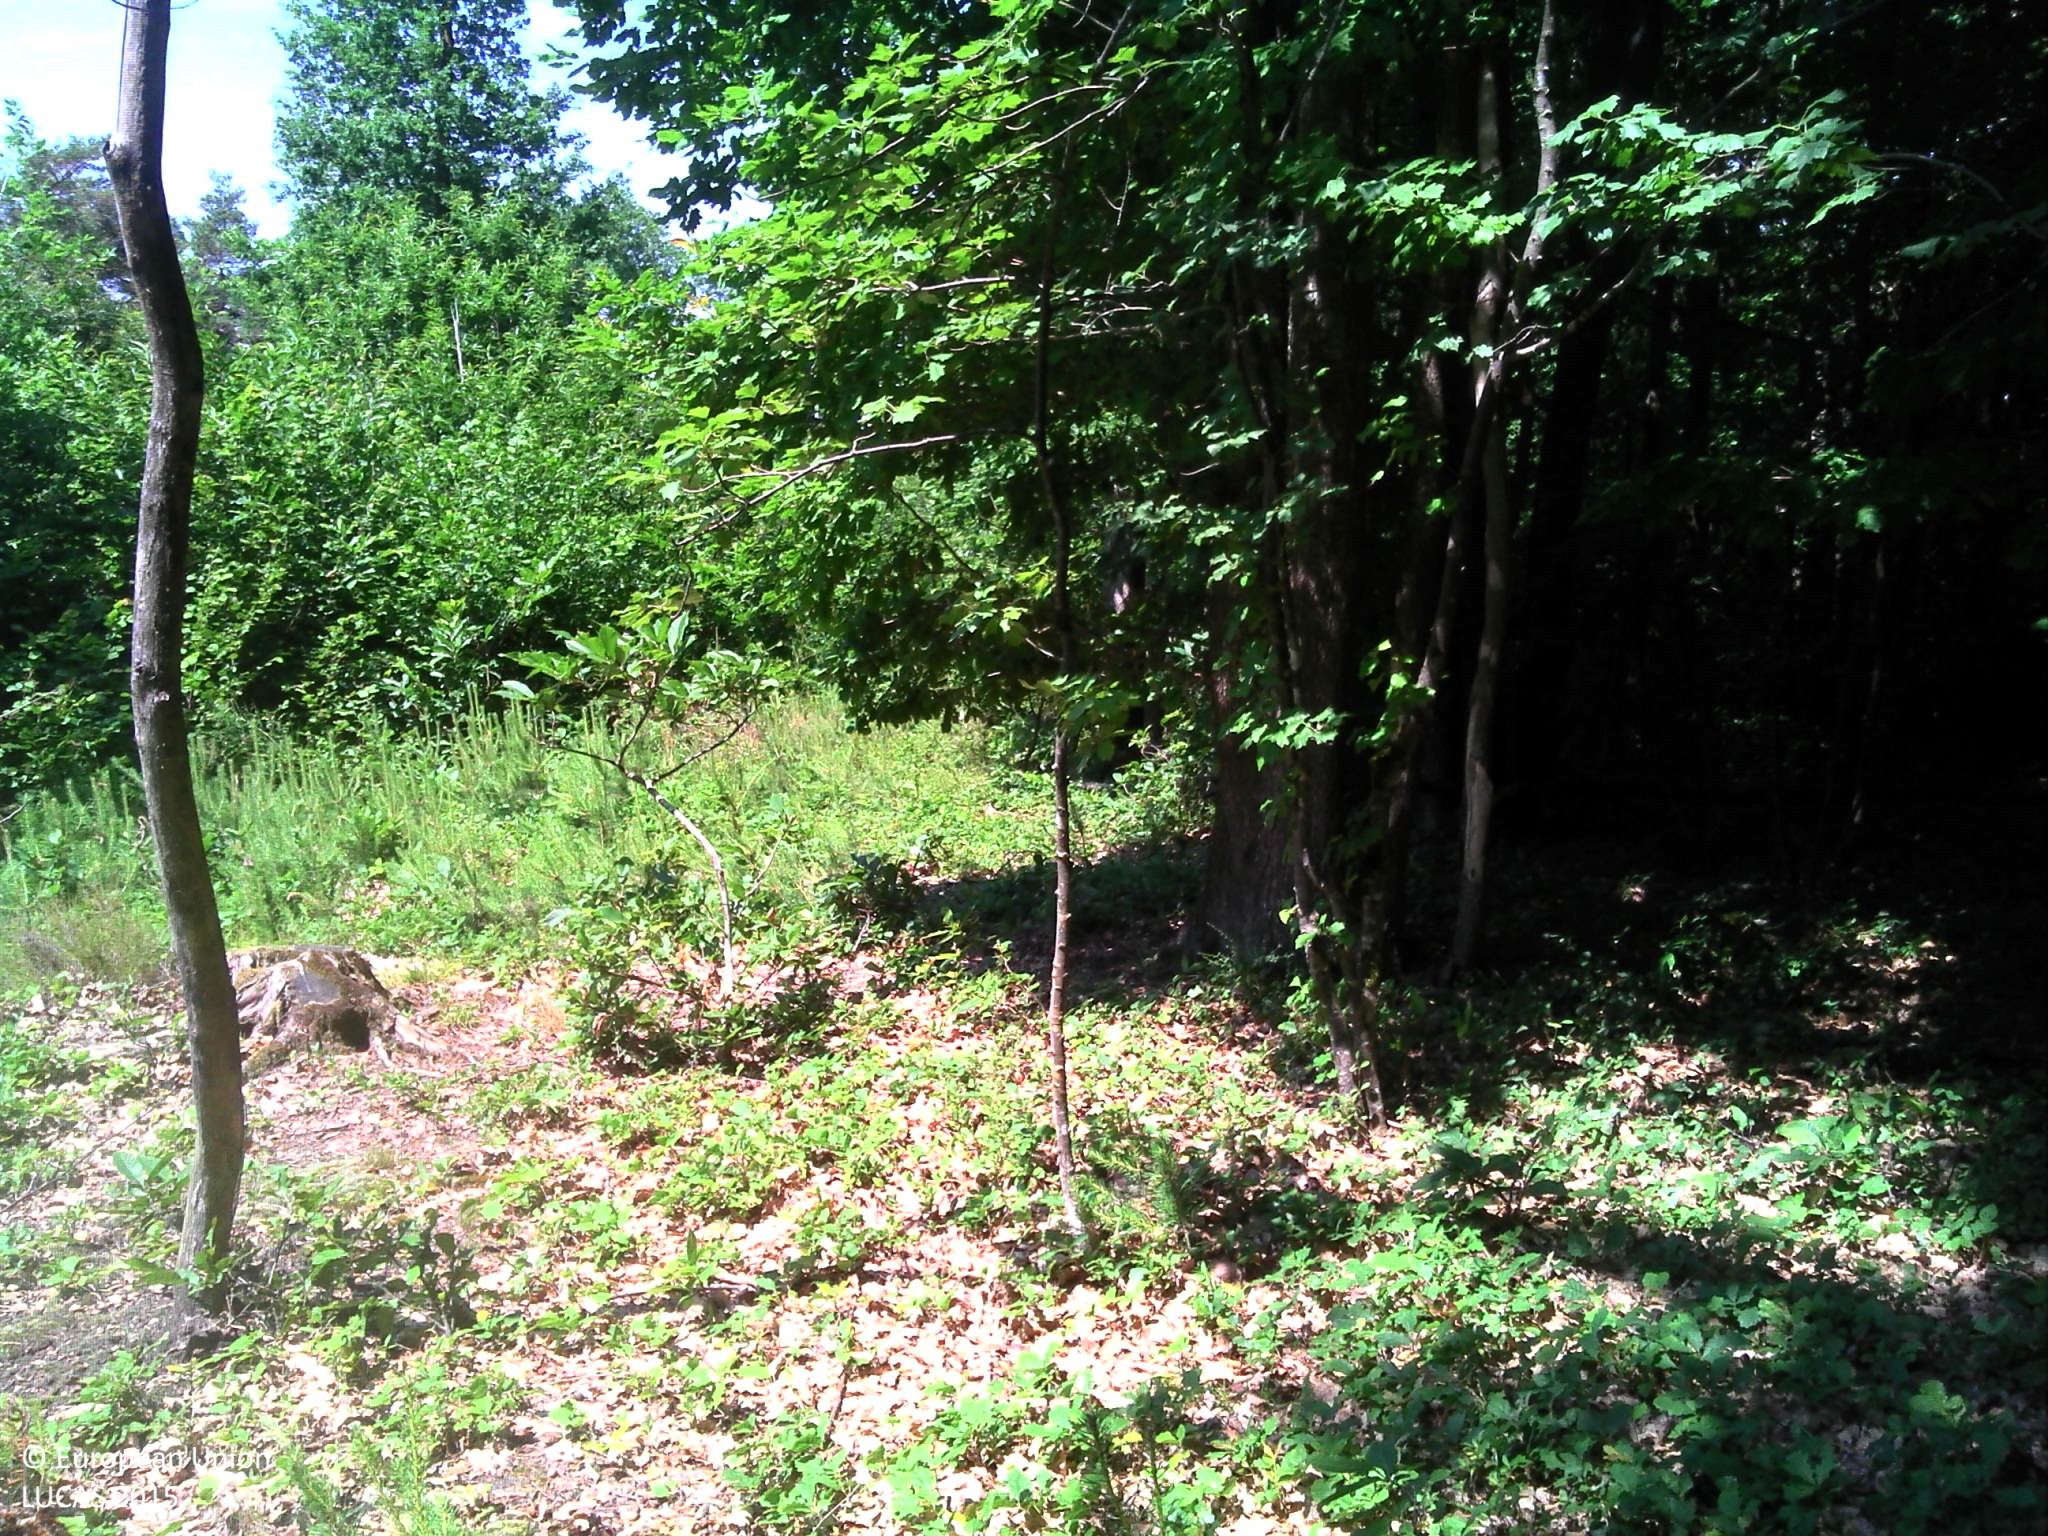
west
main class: Woodland
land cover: Broadleaved woodland
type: mesophytic deciduous forest
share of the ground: > 75 %
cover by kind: broadleaved forest trees 80 %, herbaceous plants 10 %, coniferous forest trees 5 %, lichens and mosses 5 %
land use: Forestry
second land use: Amenities, museums, leisure
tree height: > 5 m
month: June
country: FR
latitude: 47.4368
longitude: 0.7657
